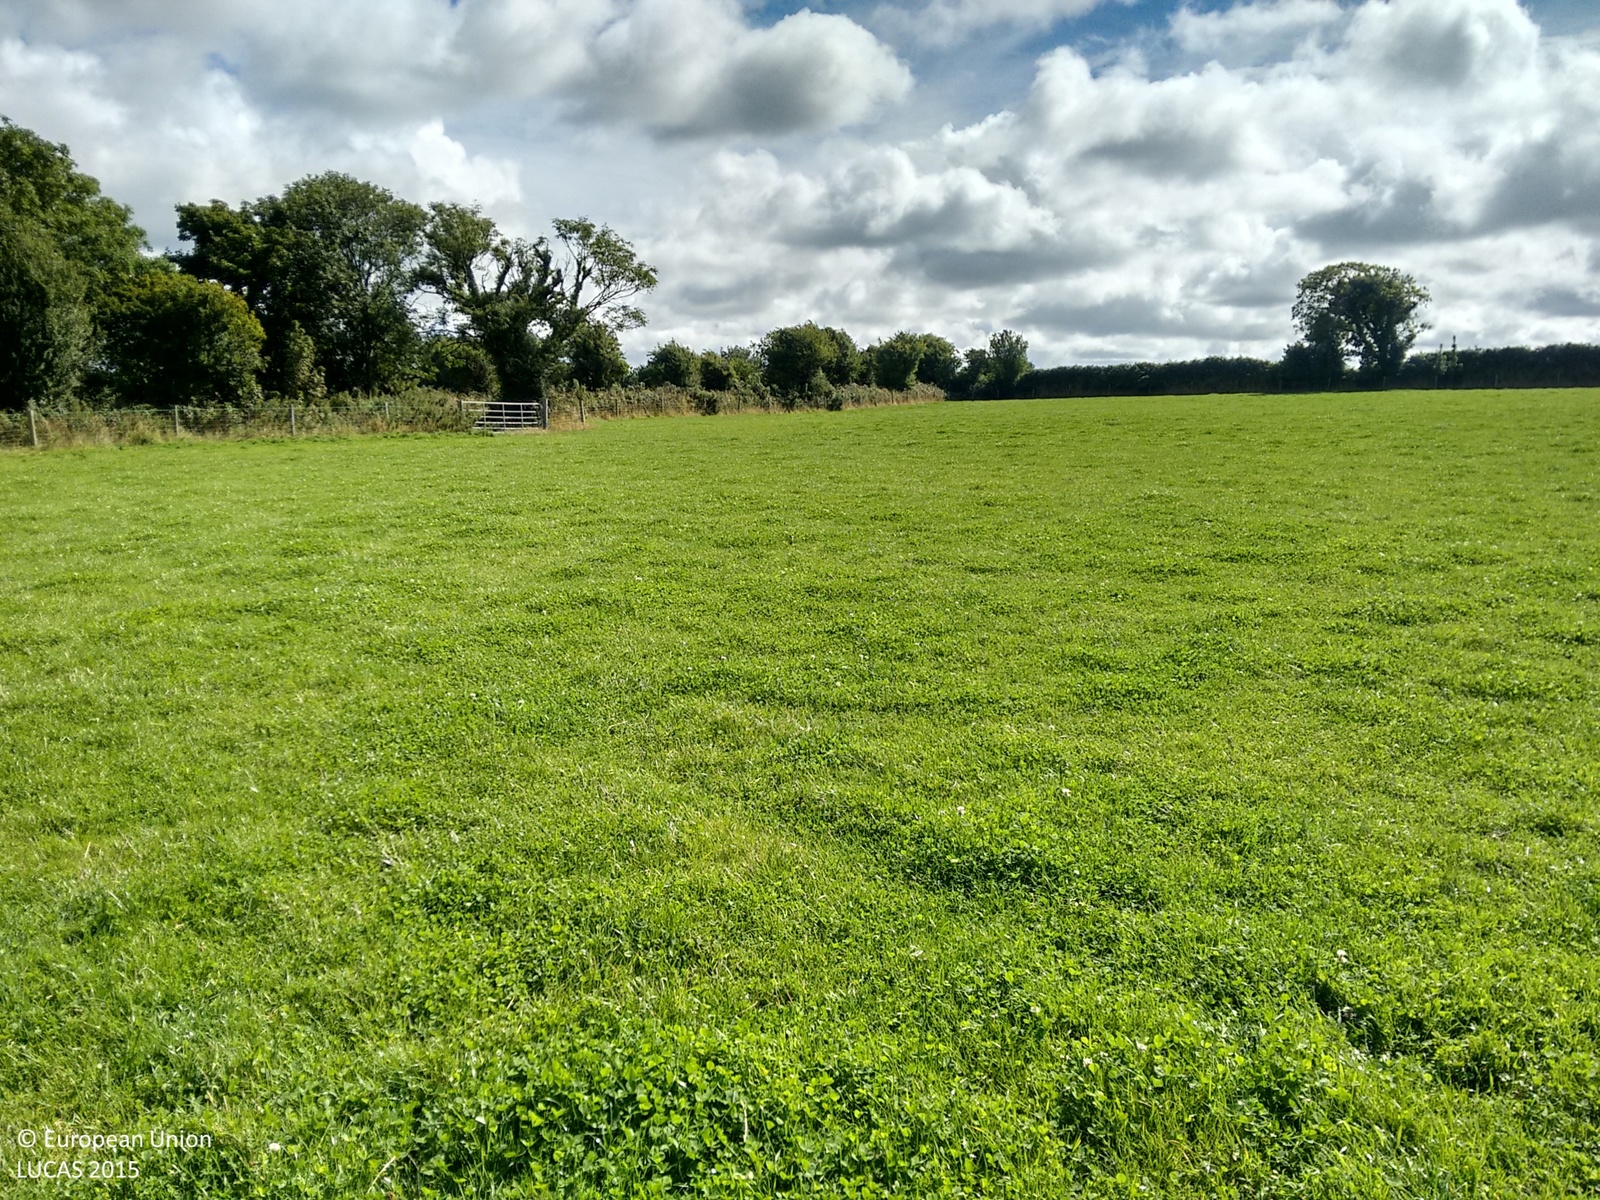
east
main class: Grassland
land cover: Grassland without tree/shrub cover
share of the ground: > 75 %
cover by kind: herbaceous plants 100 %
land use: Agriculture (excluding fallow land and kitchen gardens)
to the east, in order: Grassland without tree/shrub cover; Fences; Managed hedges; Tracks; Managed hedges; Fences; Grassland without tree/shrub cover; Fences; Abandoned hedges; Fences; Grassland without tree/shrub cover
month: August
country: IE
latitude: 52.3868
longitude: -6.6320
